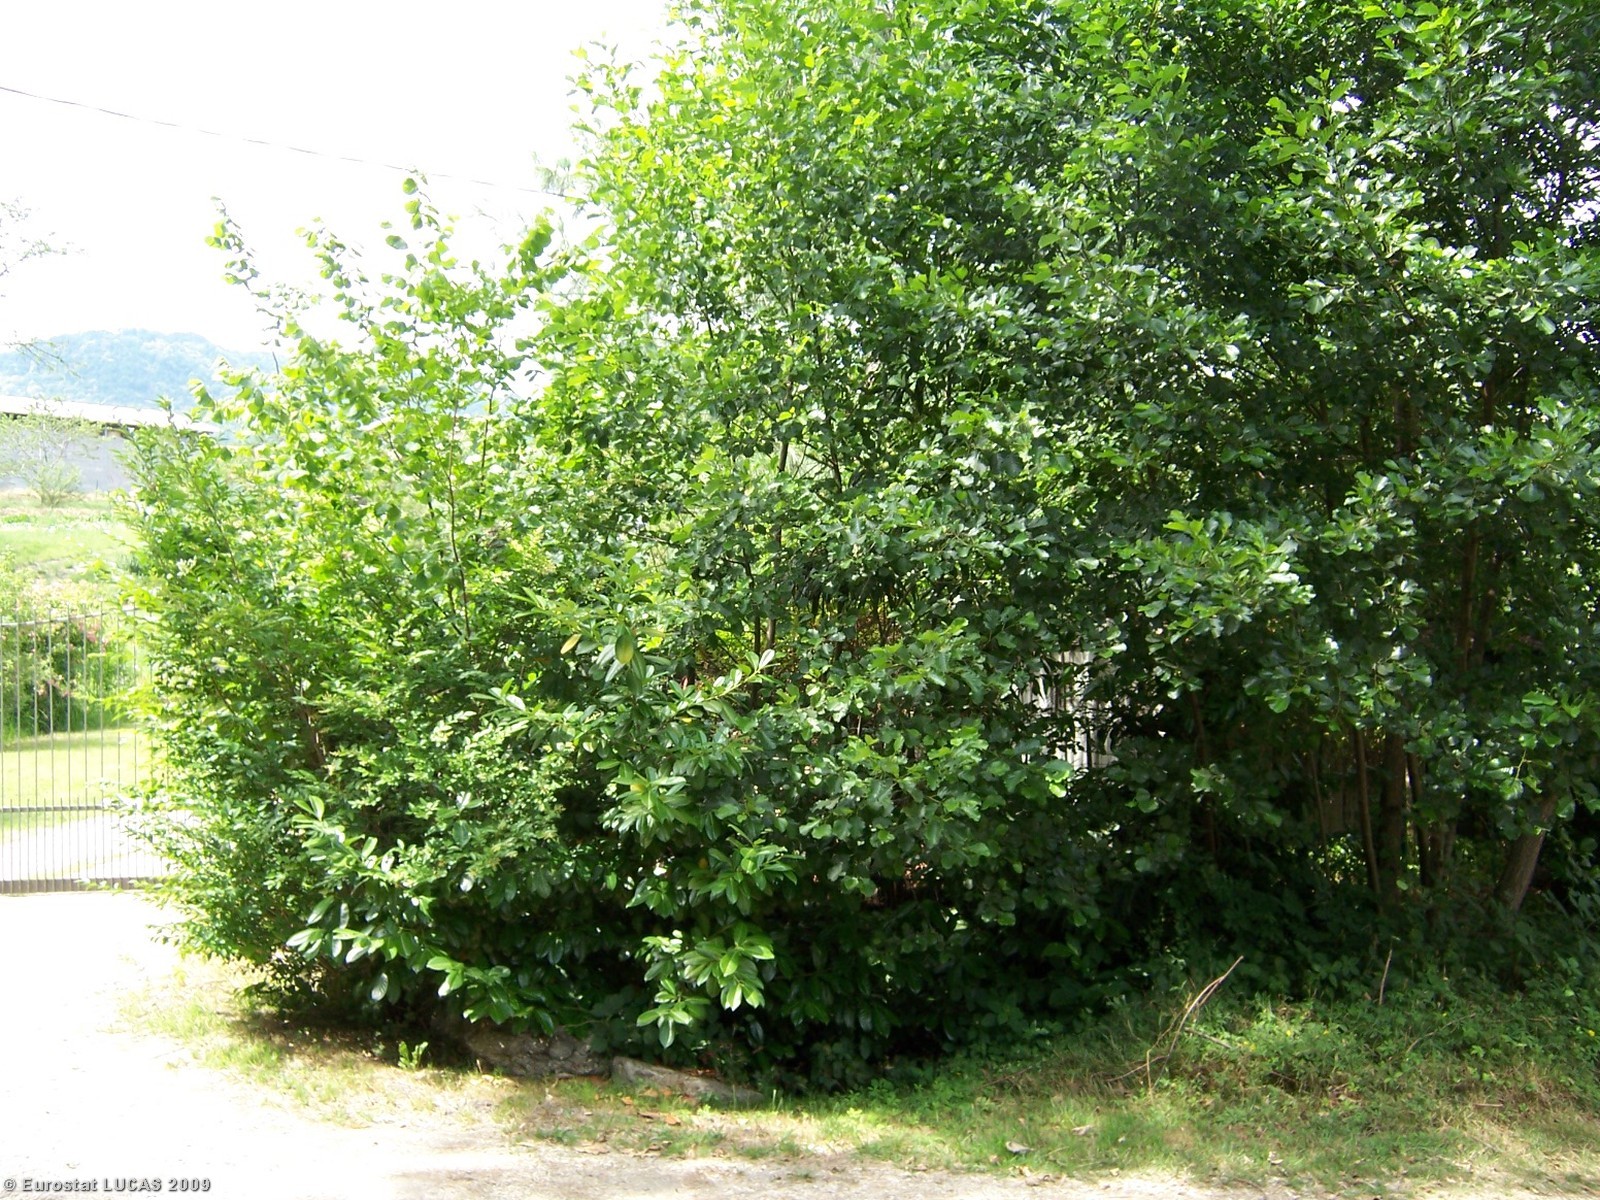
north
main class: Woodland
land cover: Broadleaved woodland
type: mesophytic deciduous forest
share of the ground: > 75 %
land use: Unused
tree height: > 5 m
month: June
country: IT
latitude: 44.9117
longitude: 7.3321
